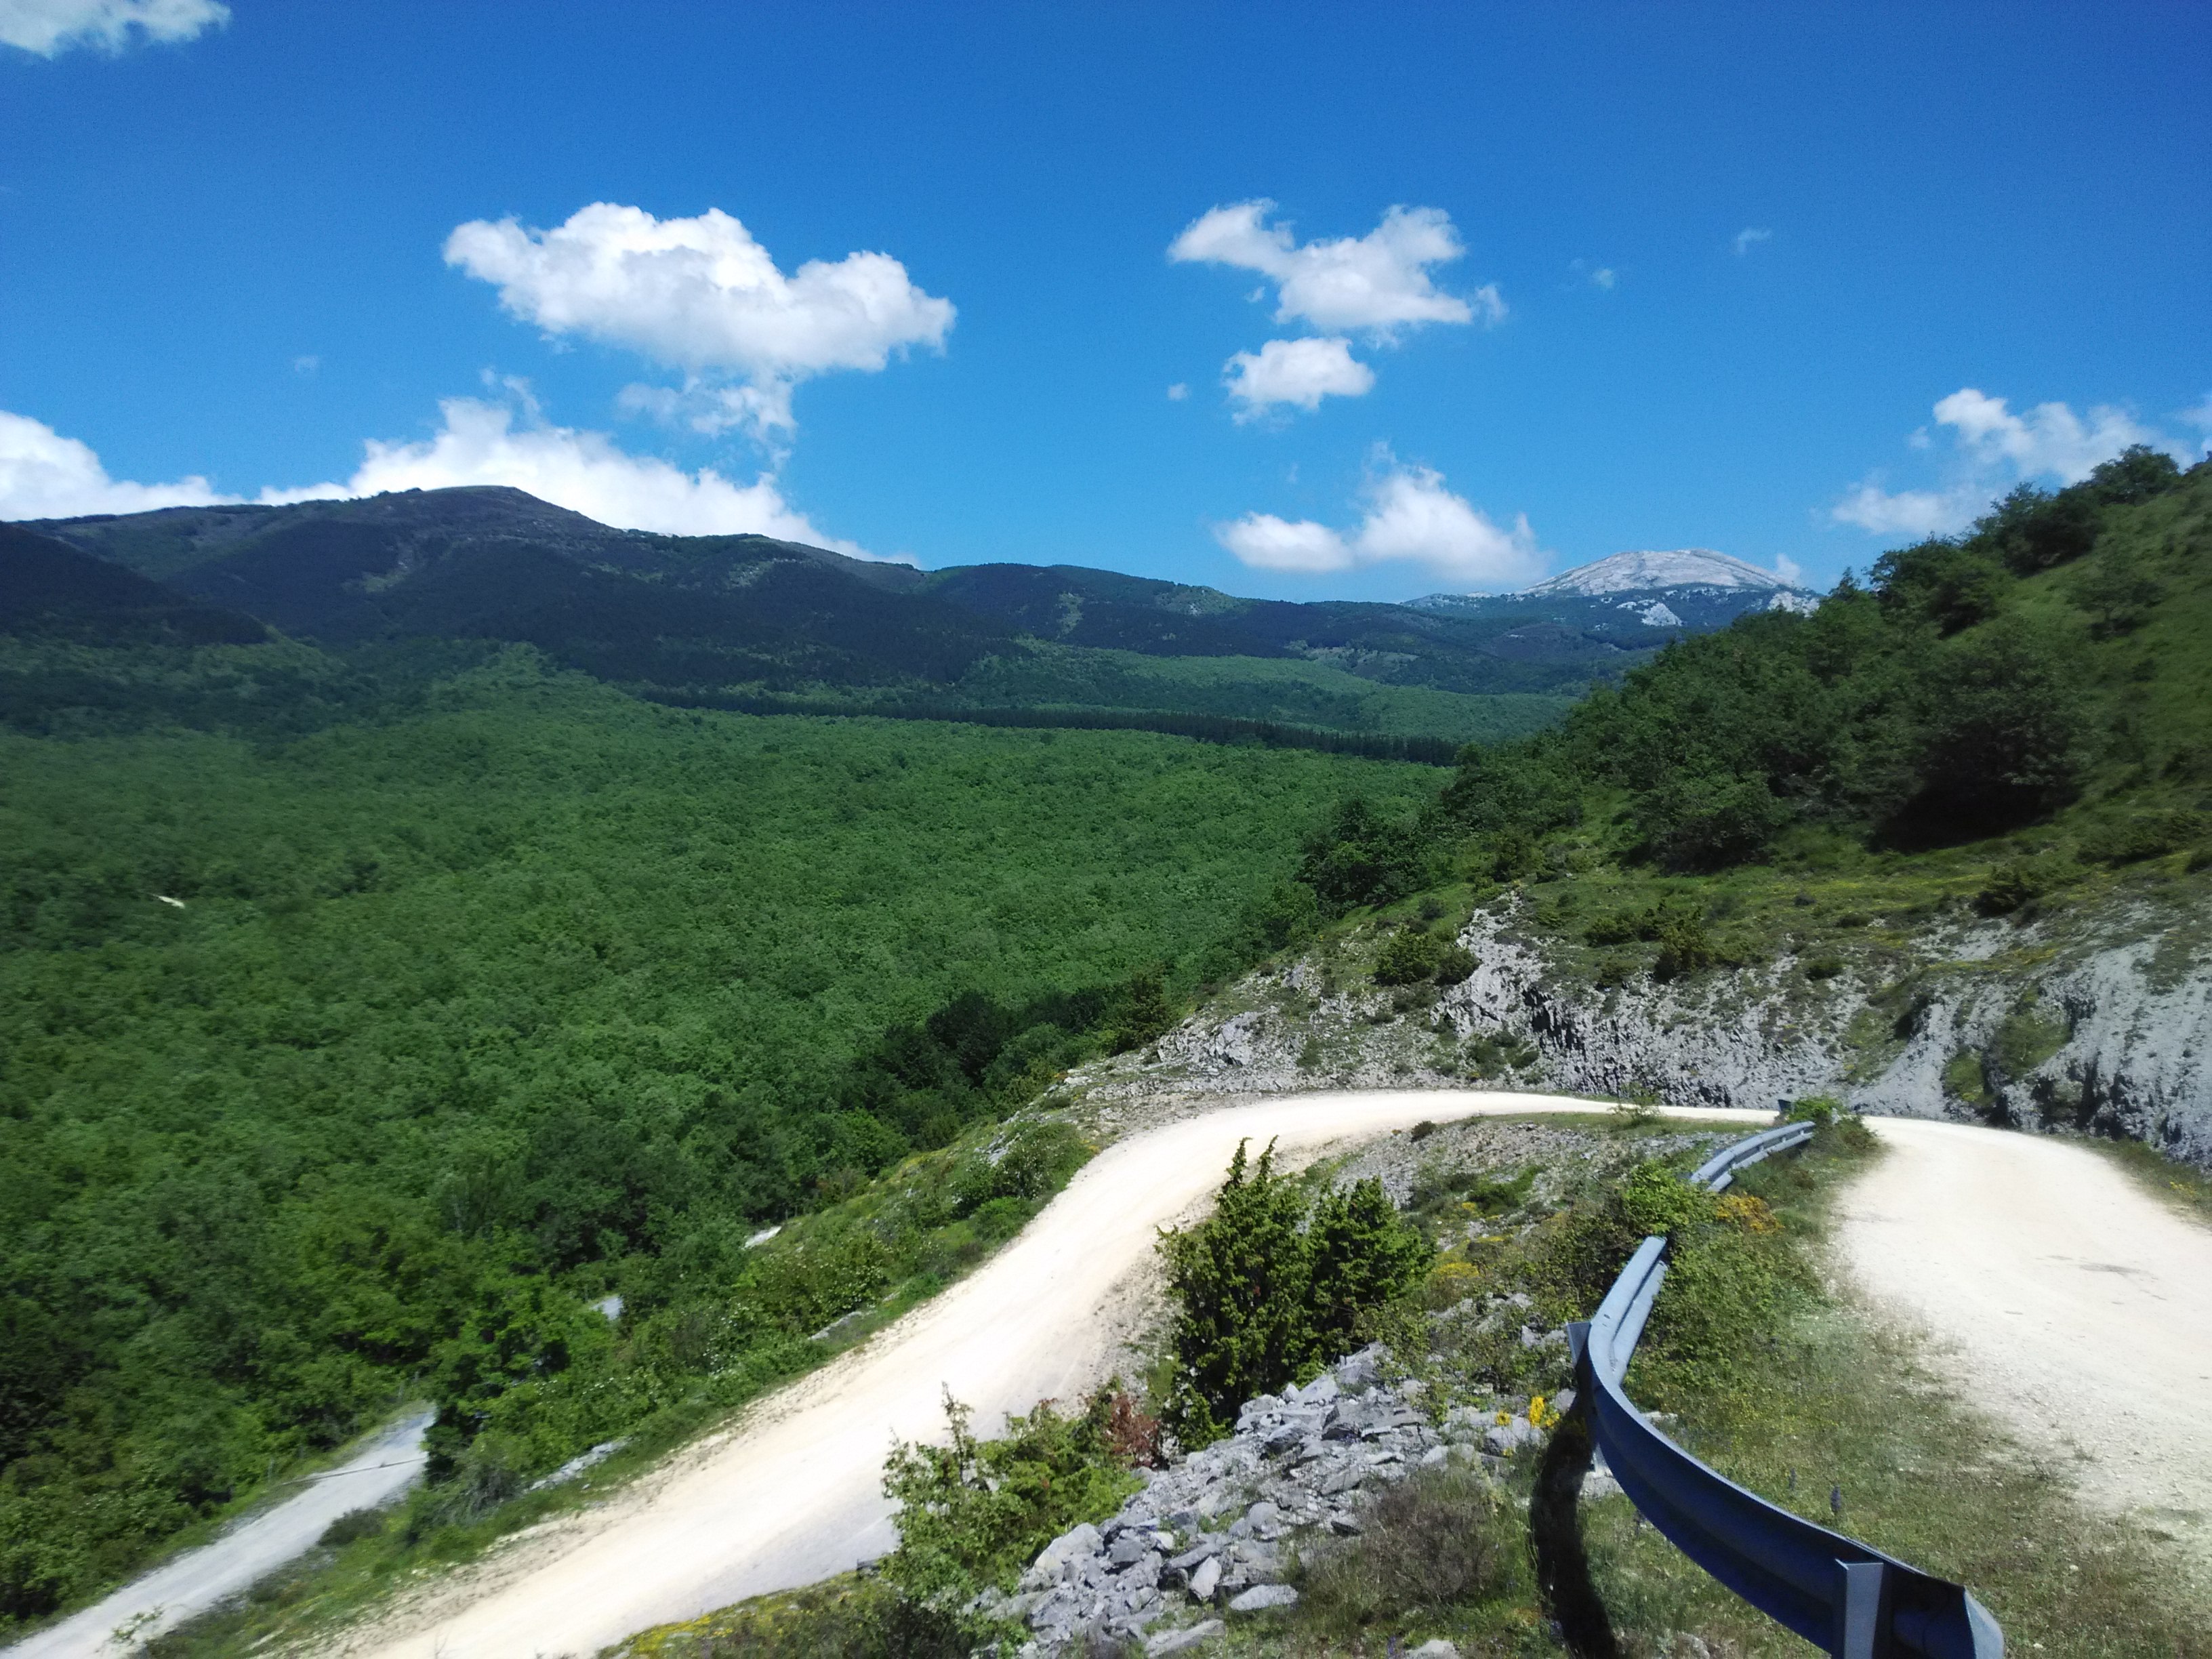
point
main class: Woodland
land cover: Broadleaved woodland
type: acidophilous oak and oak-birch forest
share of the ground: > 75 %
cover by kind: broadleaved forest trees 100 %
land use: Forestry
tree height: > 5 m
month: June
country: ES
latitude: 42.9334
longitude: -2.3630
